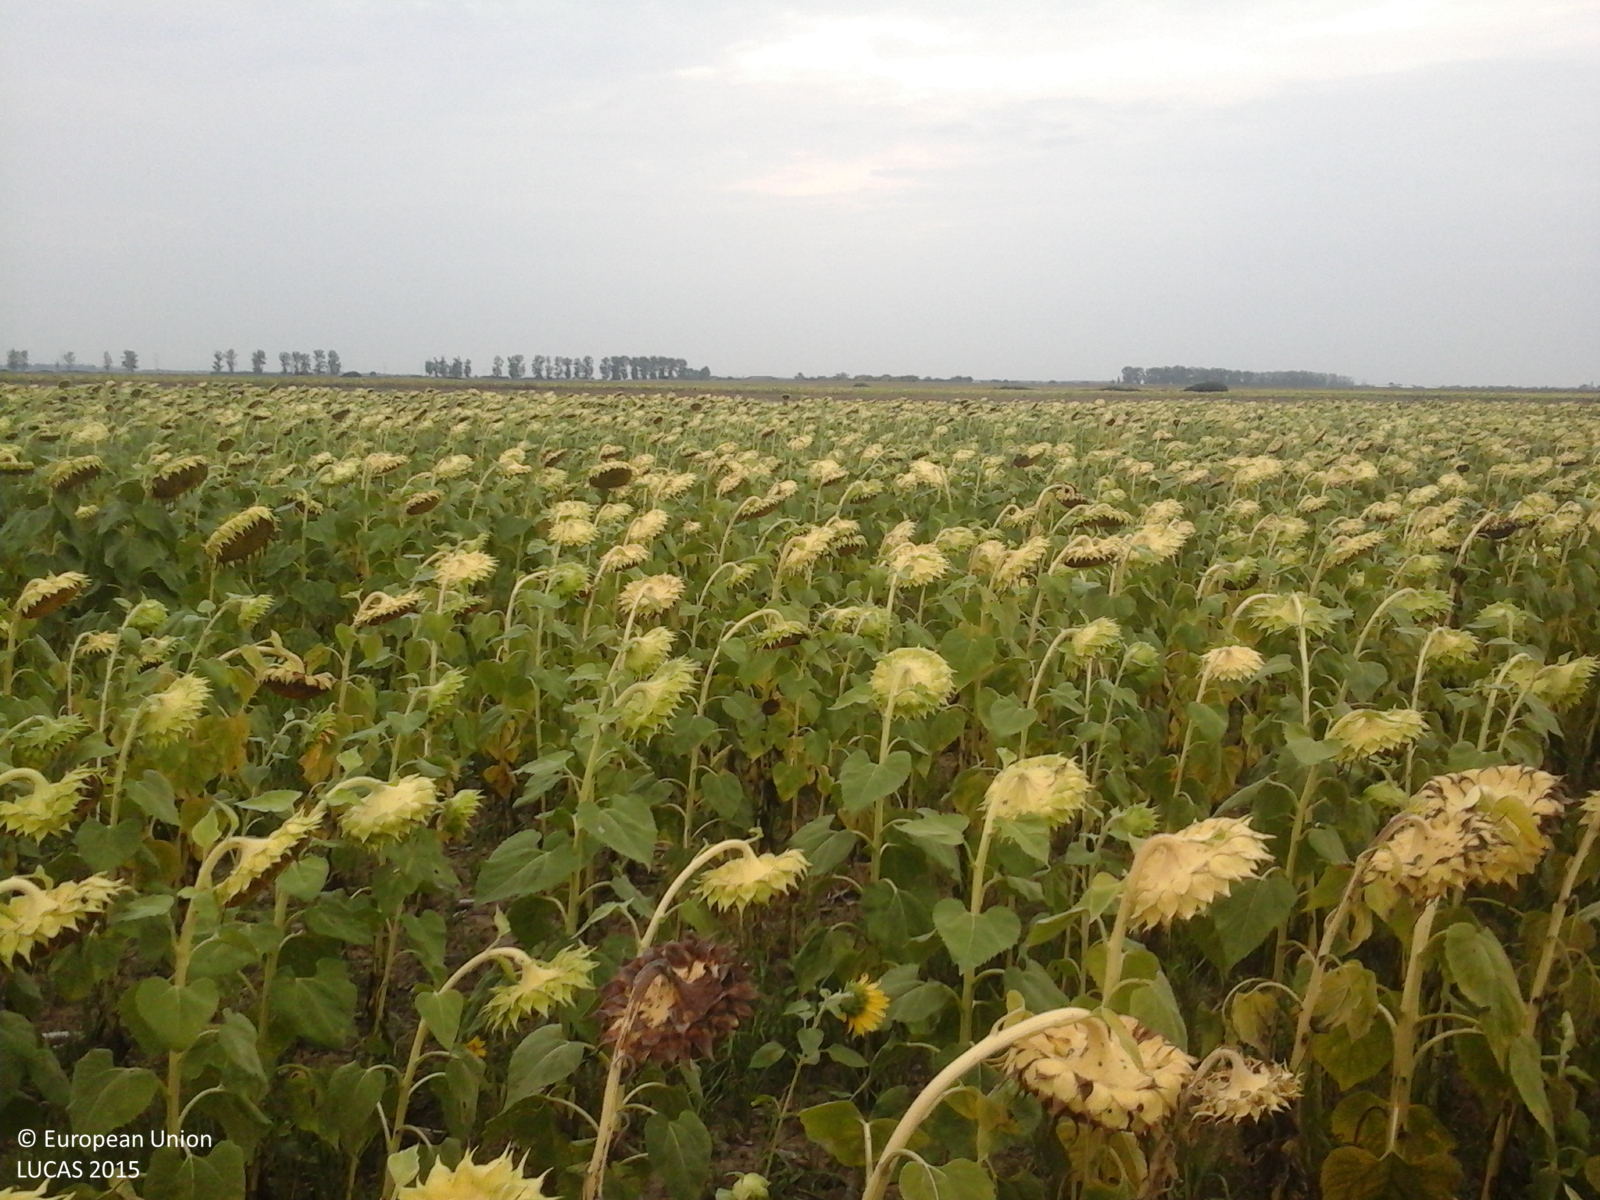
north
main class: Cropland
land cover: Sunflower
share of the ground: > 75 %
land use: Agriculture (excluding fallow land and kitchen gardens)
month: August
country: RO
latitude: 46.5029
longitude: 21.5711
